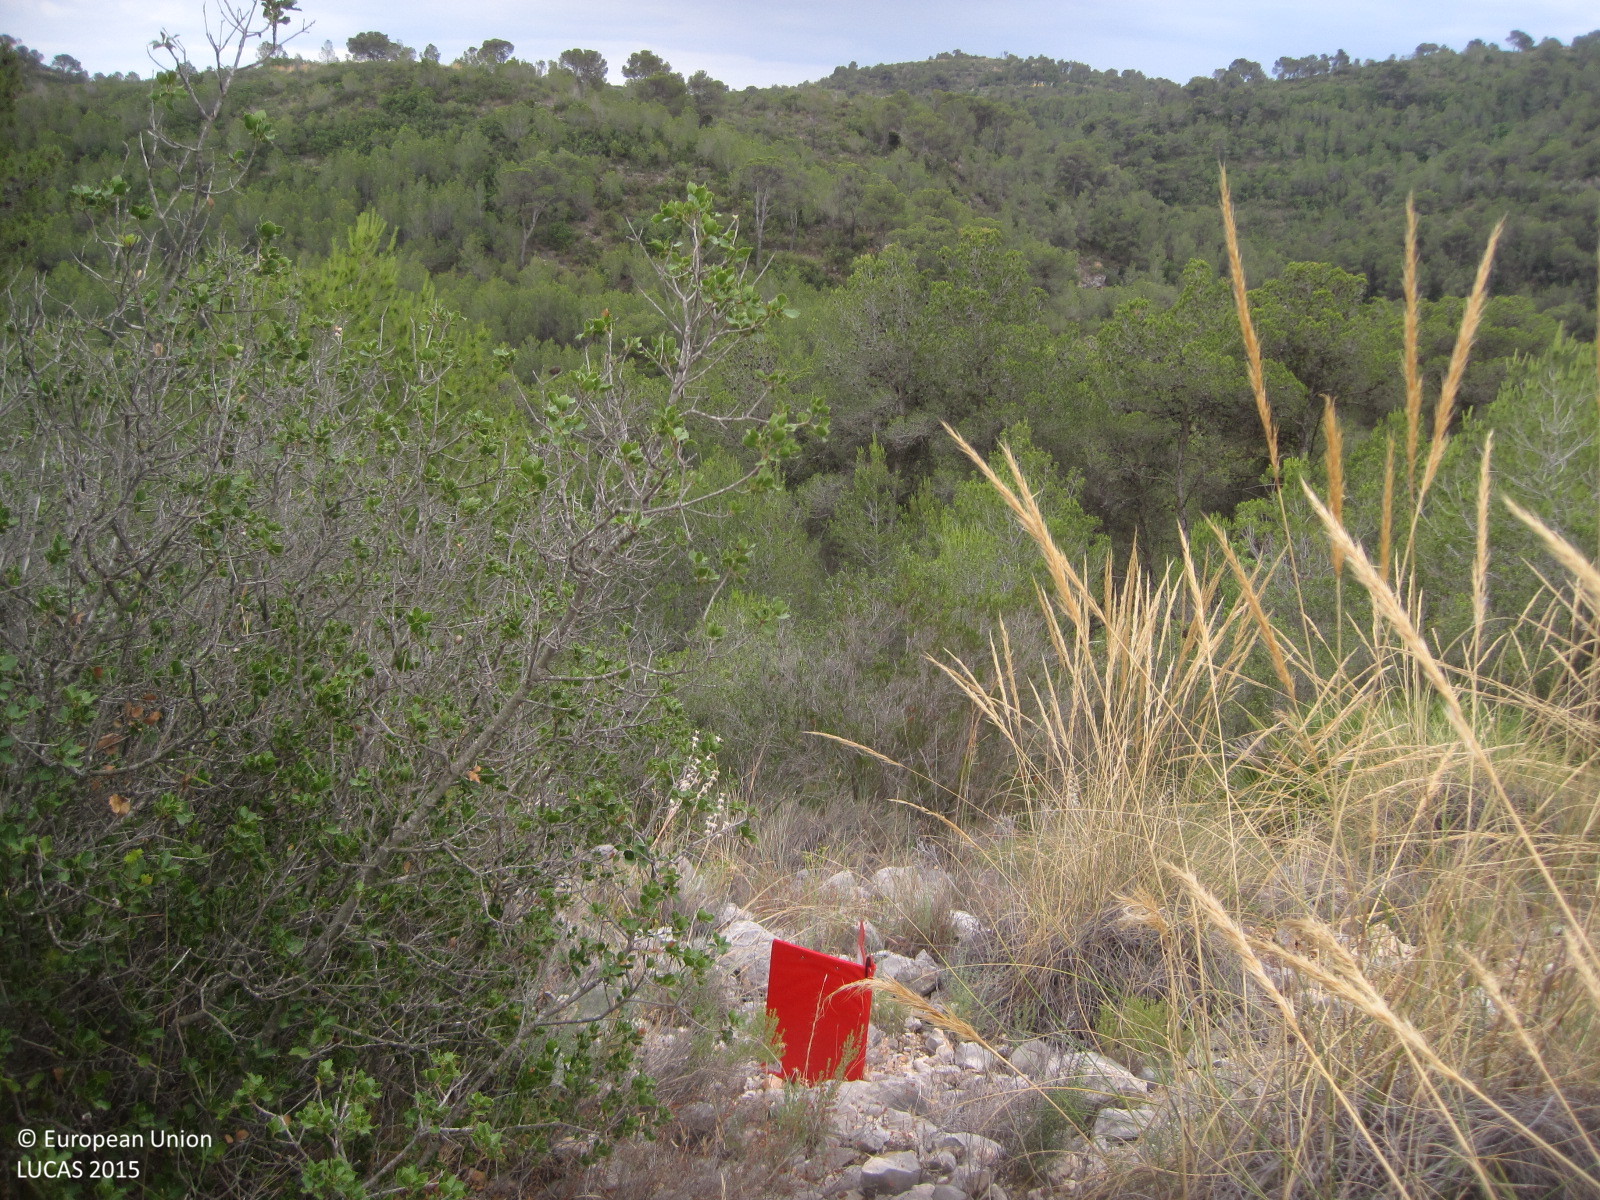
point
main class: Woodland
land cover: Pine dominated coniferous woodland
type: coniferous forest of the mediterranean region
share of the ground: 10 - 25 %
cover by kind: shrubs 30 %, herbaceous plants 30 %, coniferous forest trees 20 %, consolidated bare surface 20 %
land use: Semi-natural and natural areas not in use
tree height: > 5 m
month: June
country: ES
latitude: 39.3125
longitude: -0.5621
